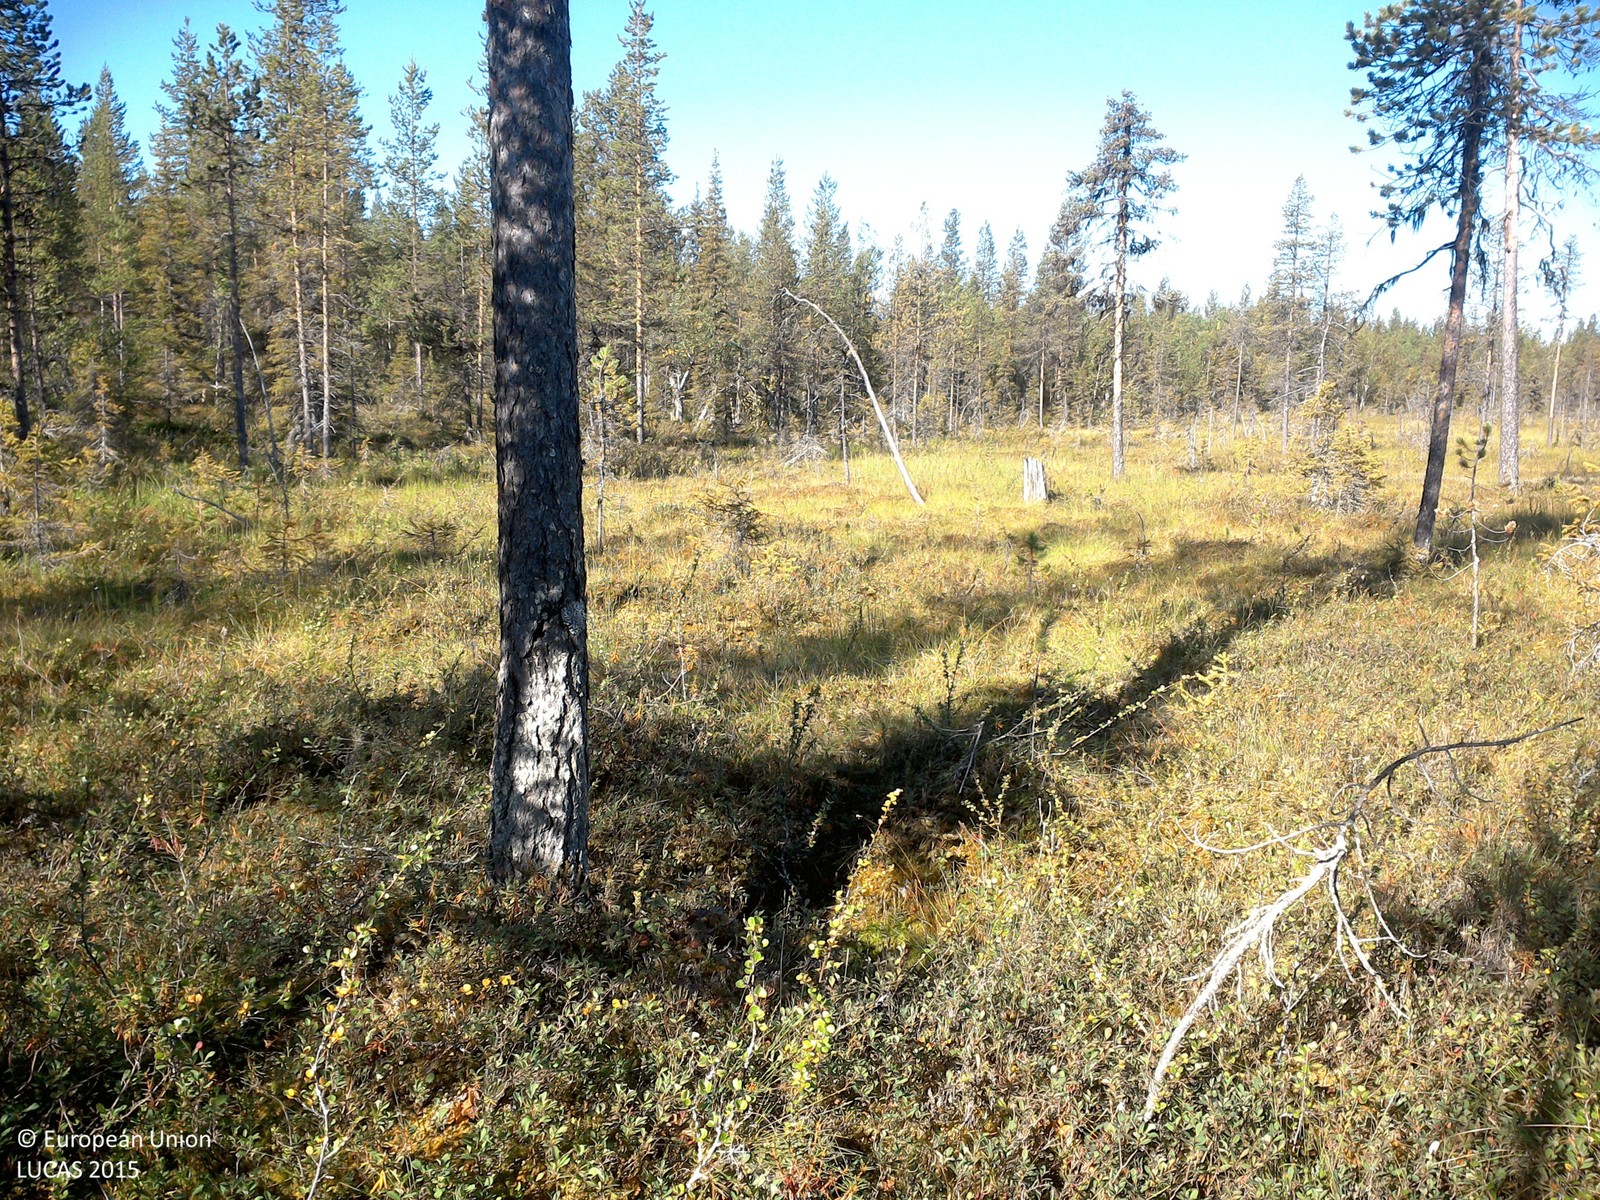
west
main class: Woodland
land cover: Pine dominated coniferous woodland
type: boreal forest
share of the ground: 25 - 50 %
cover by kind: shrubs 65 %, coniferous forest trees 20 %, broadleaved forest trees 5 %, herbaceous plants 5 %, lichens and mosses 5 %
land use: Semi-natural and natural areas not in use
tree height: > 5 m
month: August
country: SE
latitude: 67.2239
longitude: 21.4574
